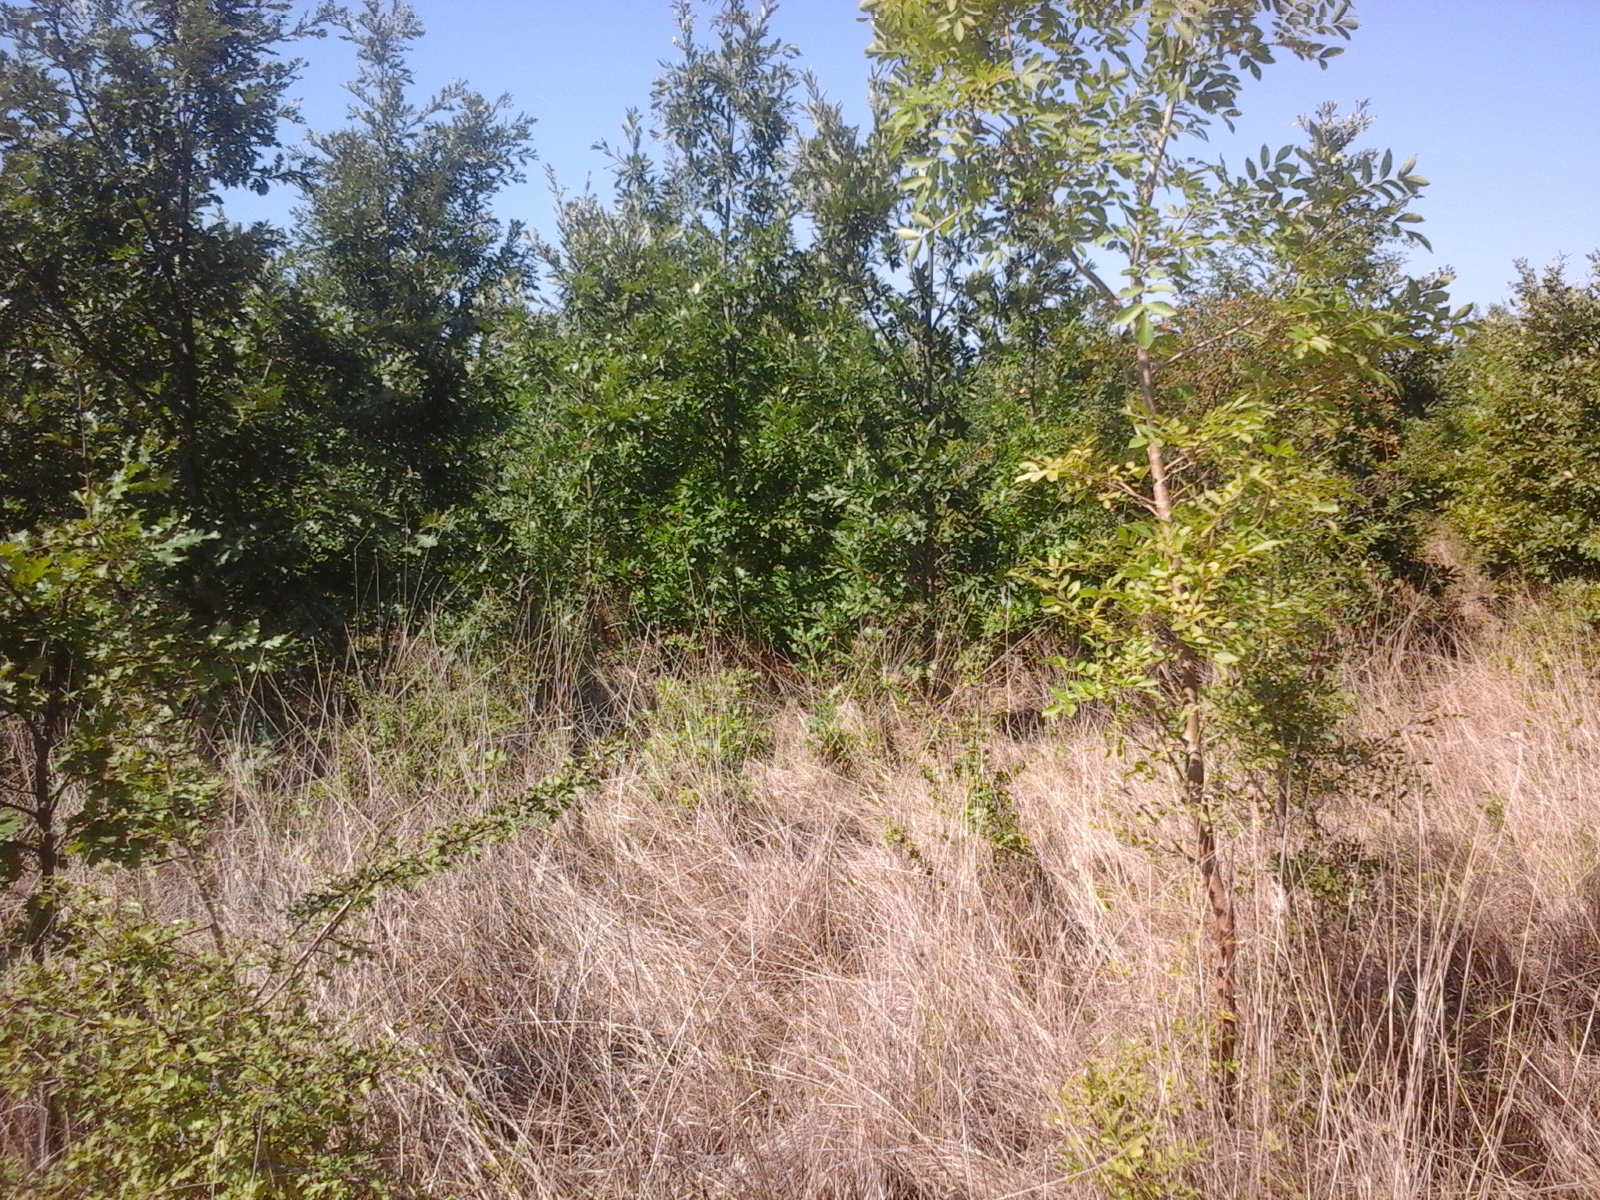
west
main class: Grassland
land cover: Grassland with sparse tree/shrub cover
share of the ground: > 75 %
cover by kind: herbaceous plants 95 %, broadleaved forest trees 5 %
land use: Fallow land
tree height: > 5 m
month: August
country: RO
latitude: 46.1201
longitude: 21.0689
